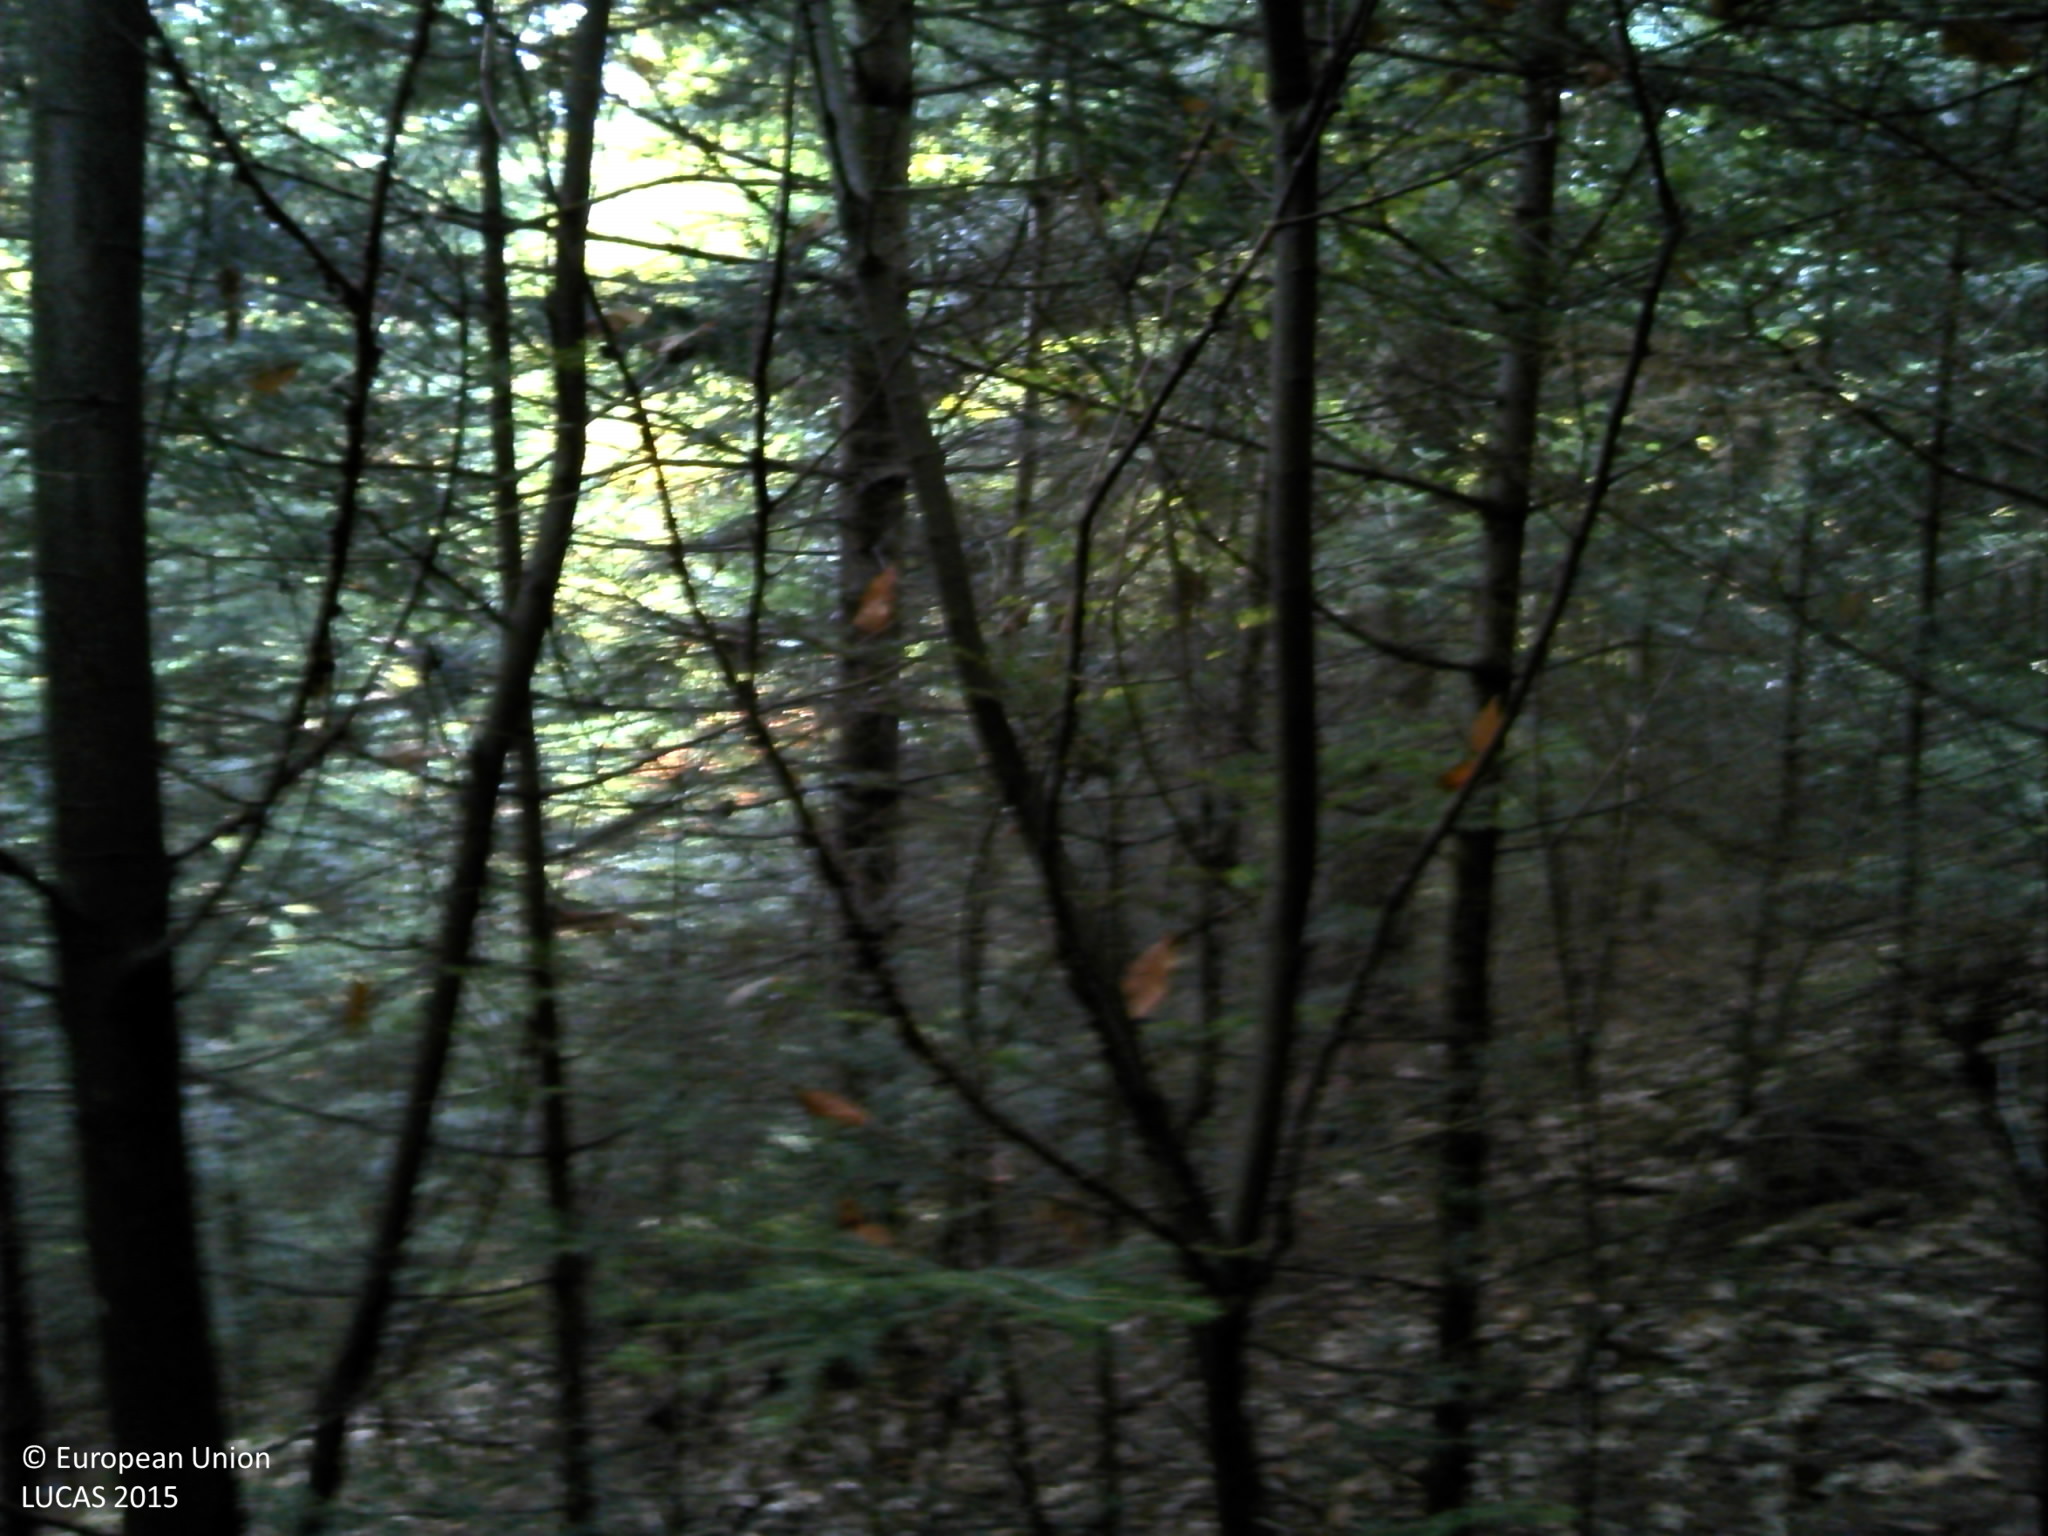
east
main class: Woodland
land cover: Spruce dominated mixed woodland
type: alpine coniferous forest
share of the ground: > 75 %
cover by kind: coniferous forest trees 60 %, broadleaved forest trees 30 %, unconsolidated bare surface 10 %
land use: Forestry
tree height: > 5 m
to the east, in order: Spruce dominated mixed woodland; Fences; Rivers and streams; Shrubland with sparse tree cover; Fences; Broadleaved woodland
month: October
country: FR
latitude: 45.5729
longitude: 3.7617
